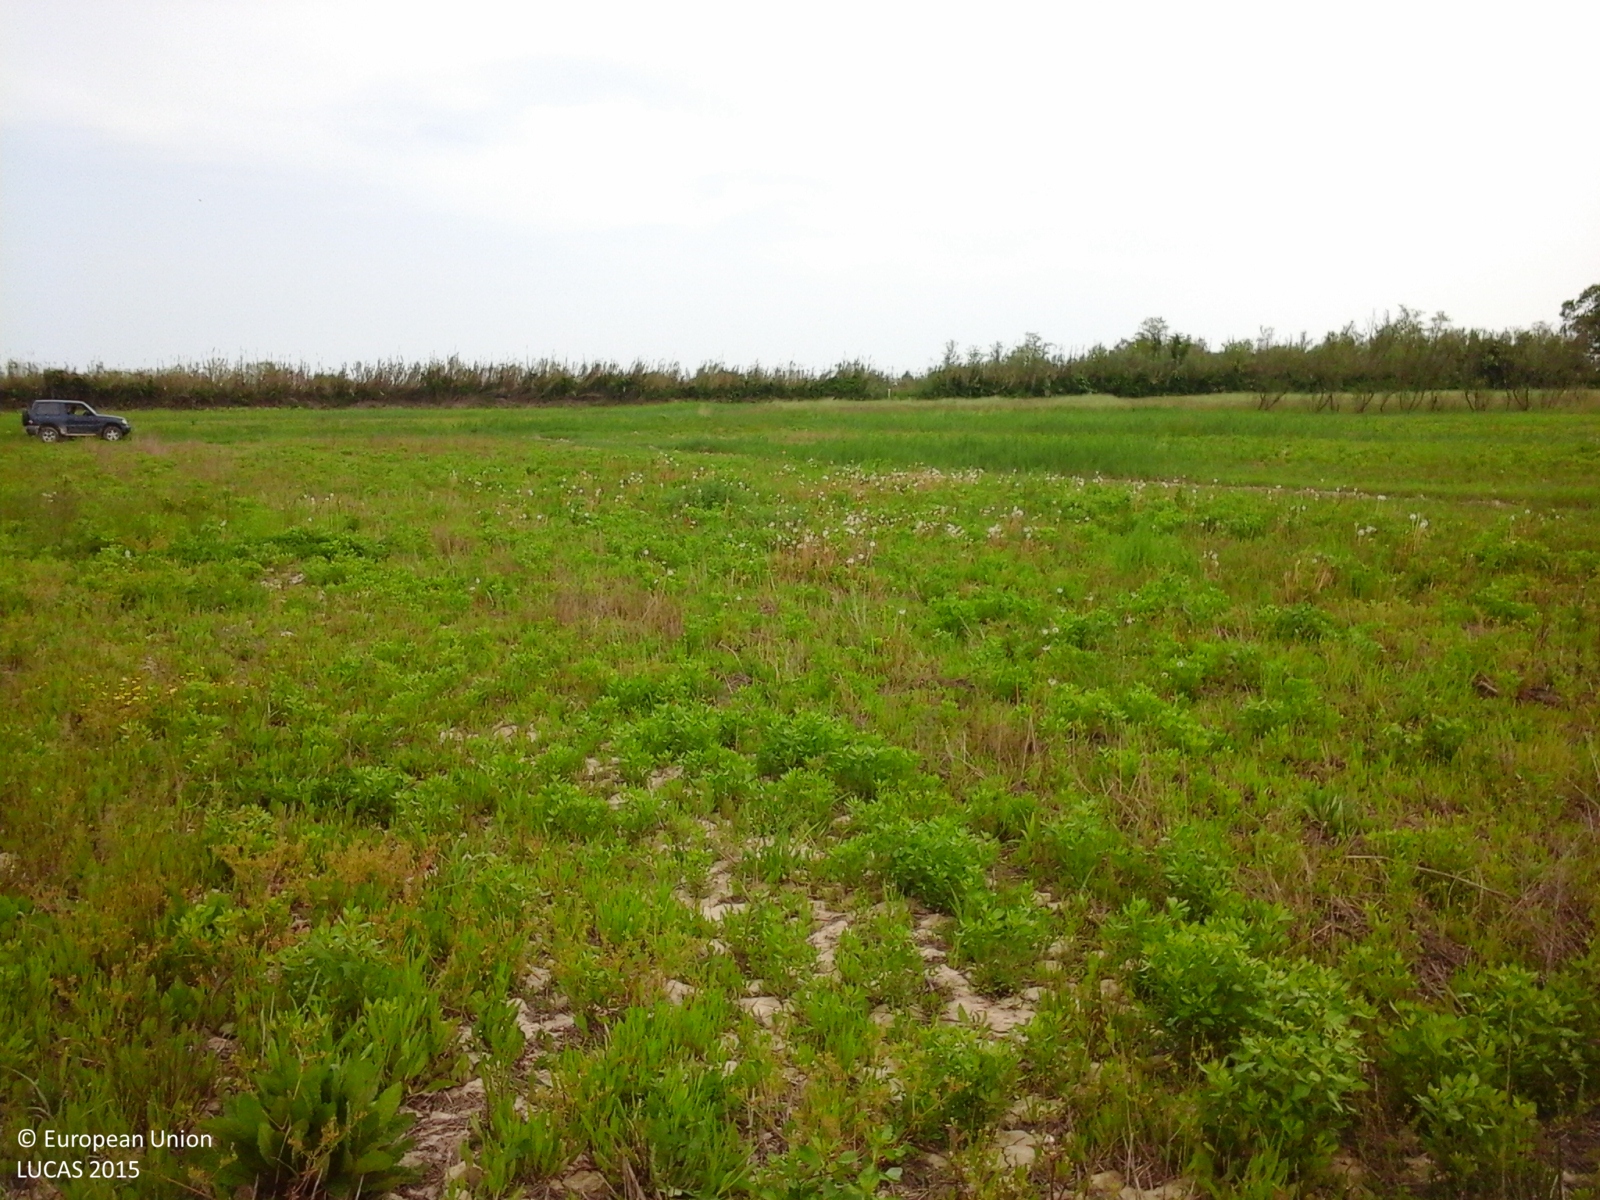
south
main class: Grassland
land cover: Spontaneously vegetated surfaces
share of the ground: > 75 %
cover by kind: herbaceous plants 80 %, consolidated bare surface 20 %
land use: Fallow land
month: May
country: IT
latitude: 45.5414
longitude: 12.7239
